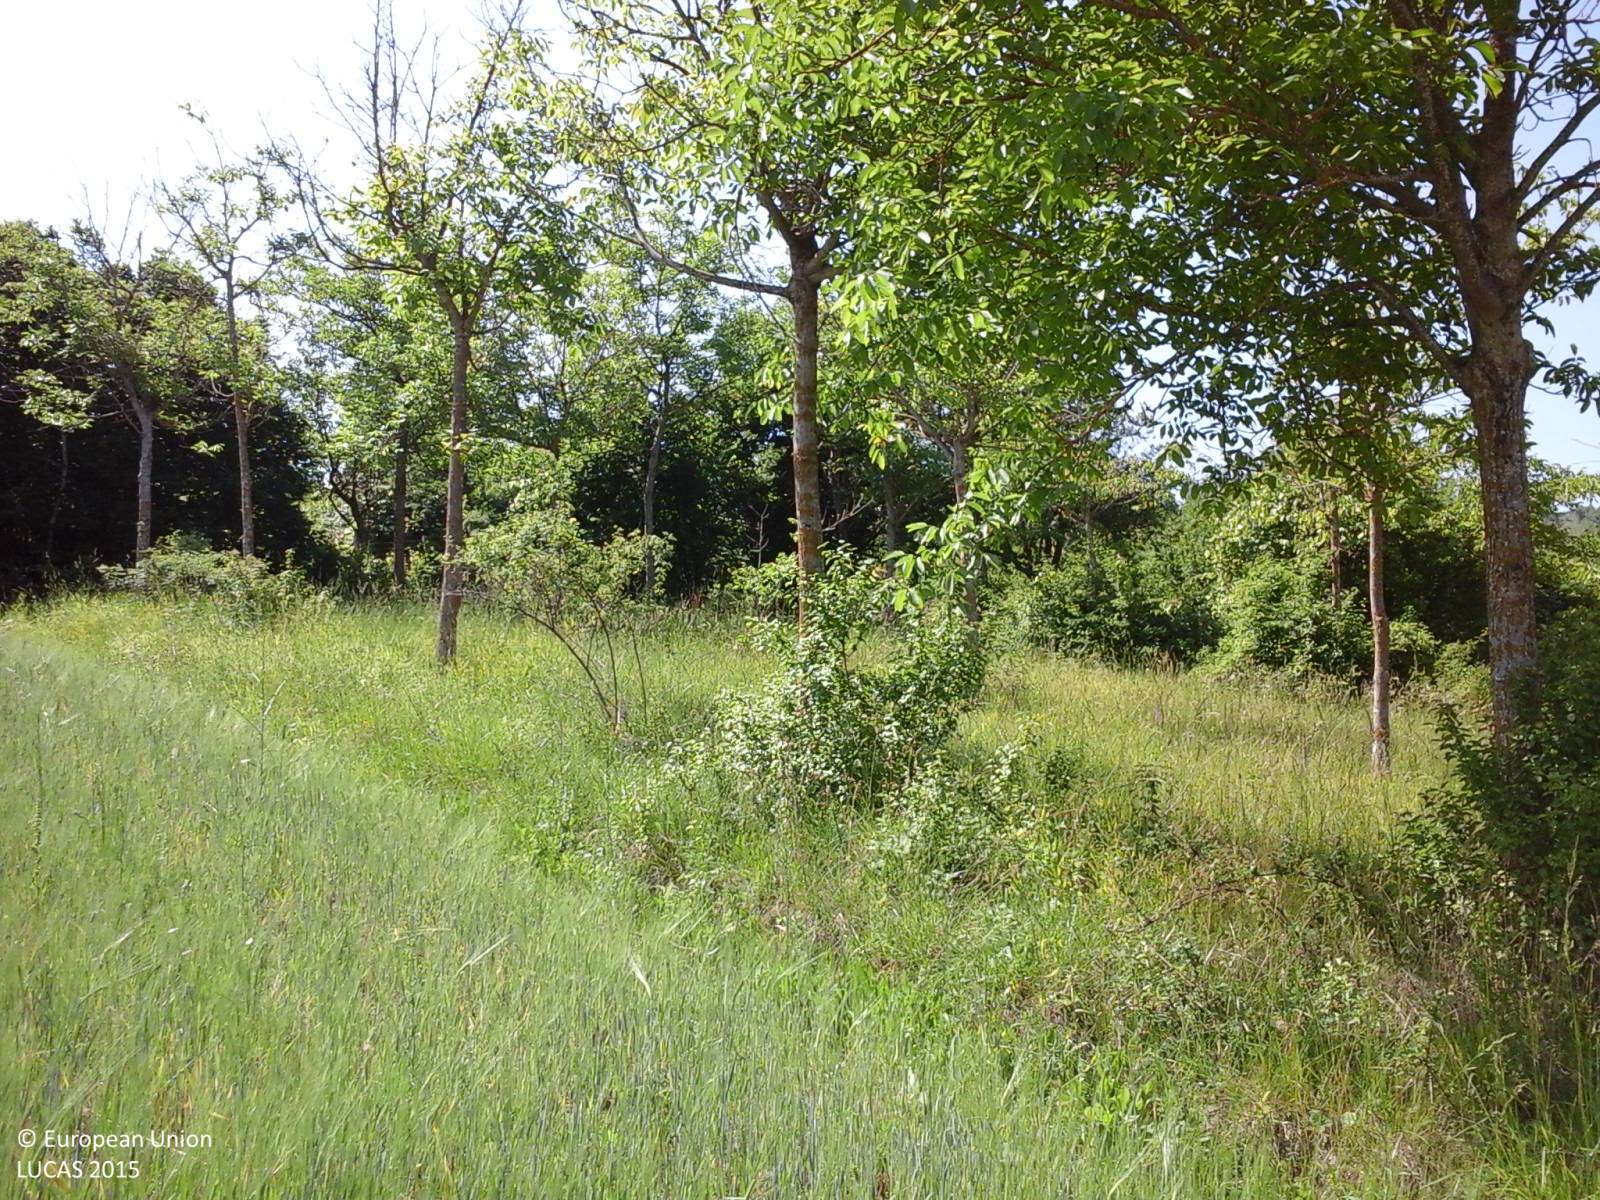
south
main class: Cropland
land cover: Barley
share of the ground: > 75 %
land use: Agriculture (excluding fallow land and kitchen gardens)
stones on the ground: < 10 %
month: June
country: IT
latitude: 42.1154
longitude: 13.7249
